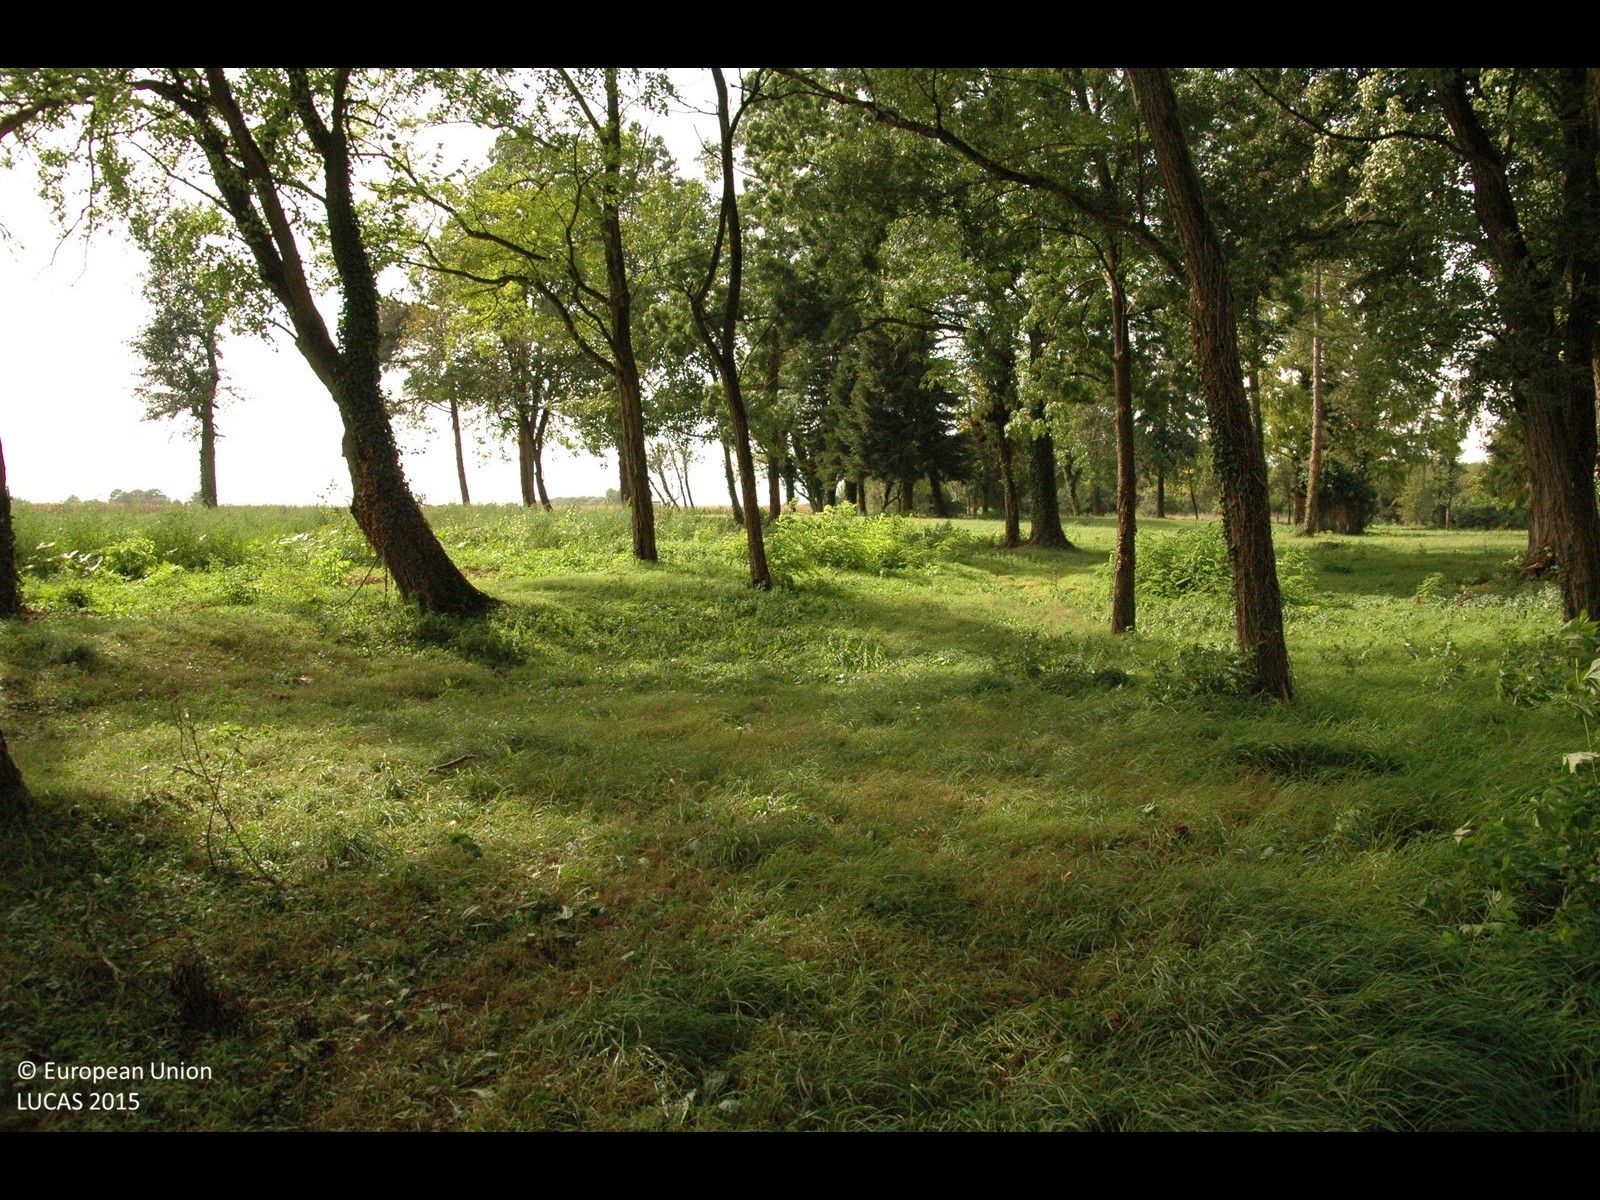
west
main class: Woodland
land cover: Broadleaved woodland
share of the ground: > 75 %
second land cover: Grassland without tree/shrub cover
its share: > 75 %
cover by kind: broadleaved forest trees 80 %, herbaceous plants 20 %
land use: Amenities, museums, leisure
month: September
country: HR
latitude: 45.7327
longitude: 15.9732
